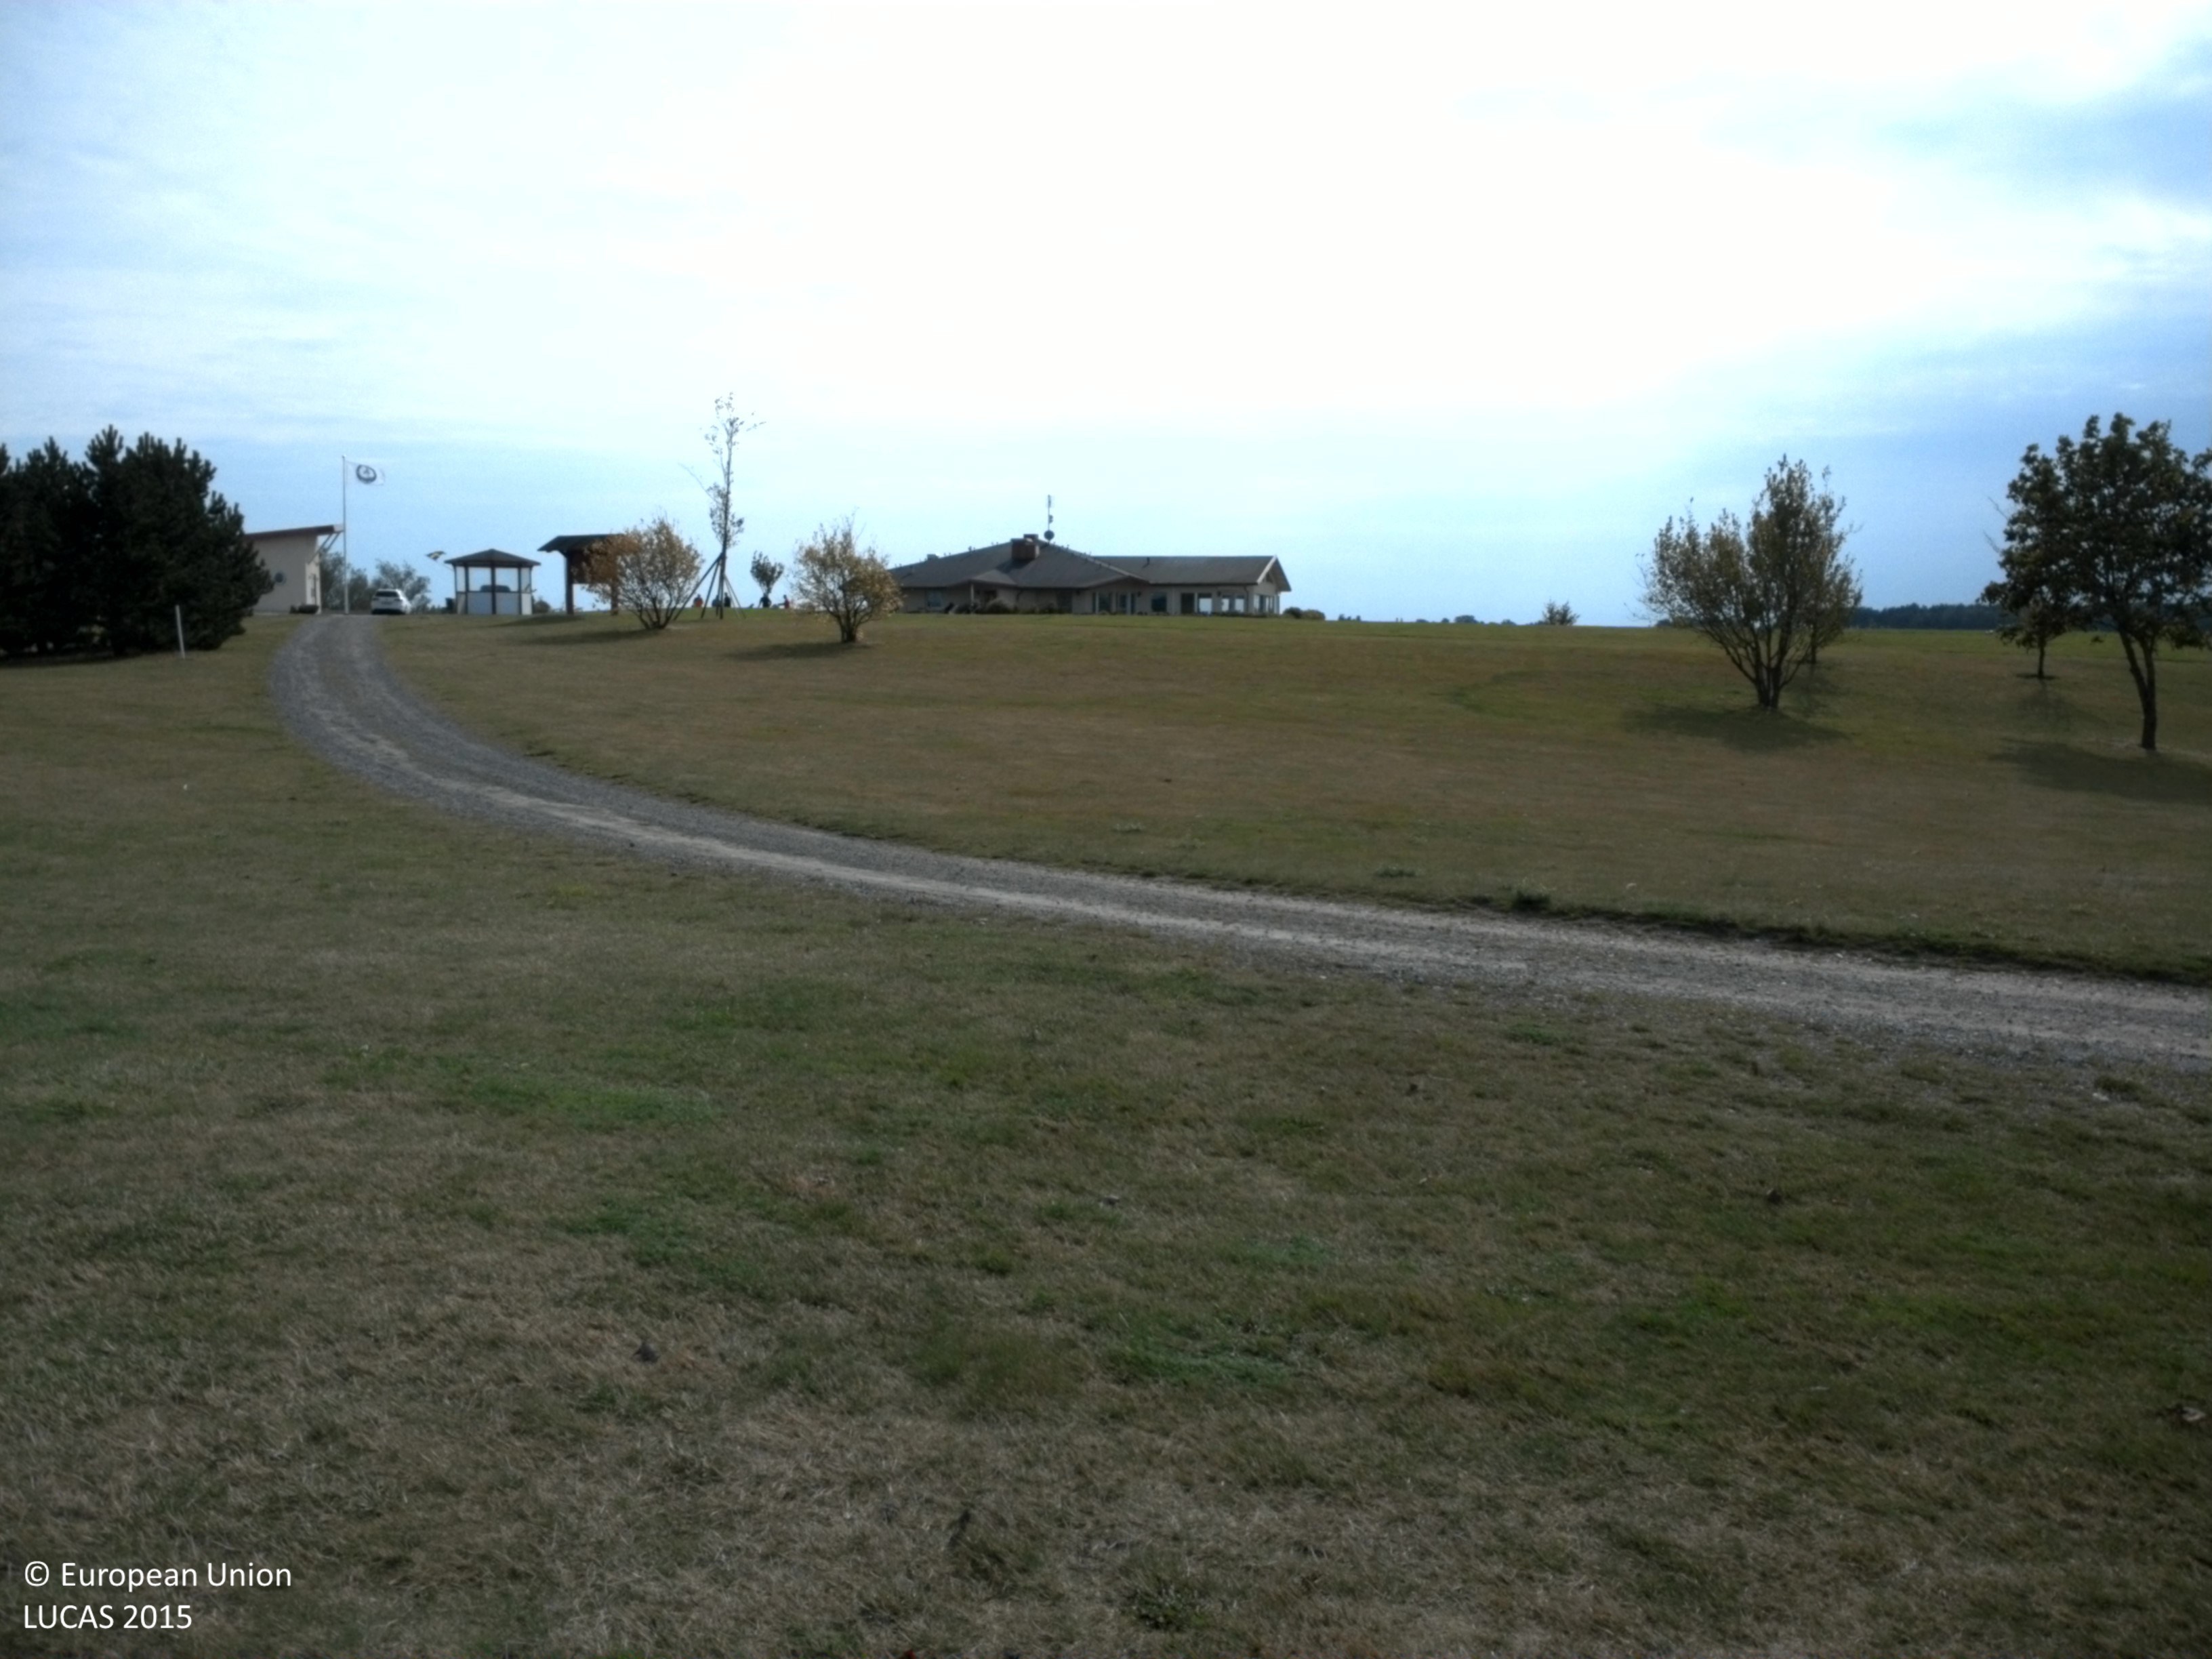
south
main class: Grassland
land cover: Grassland without tree/shrub cover
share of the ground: > 75 %
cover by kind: herbaceous plants 100 %
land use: Sport
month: September
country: SE
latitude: 55.5323
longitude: 13.9752
